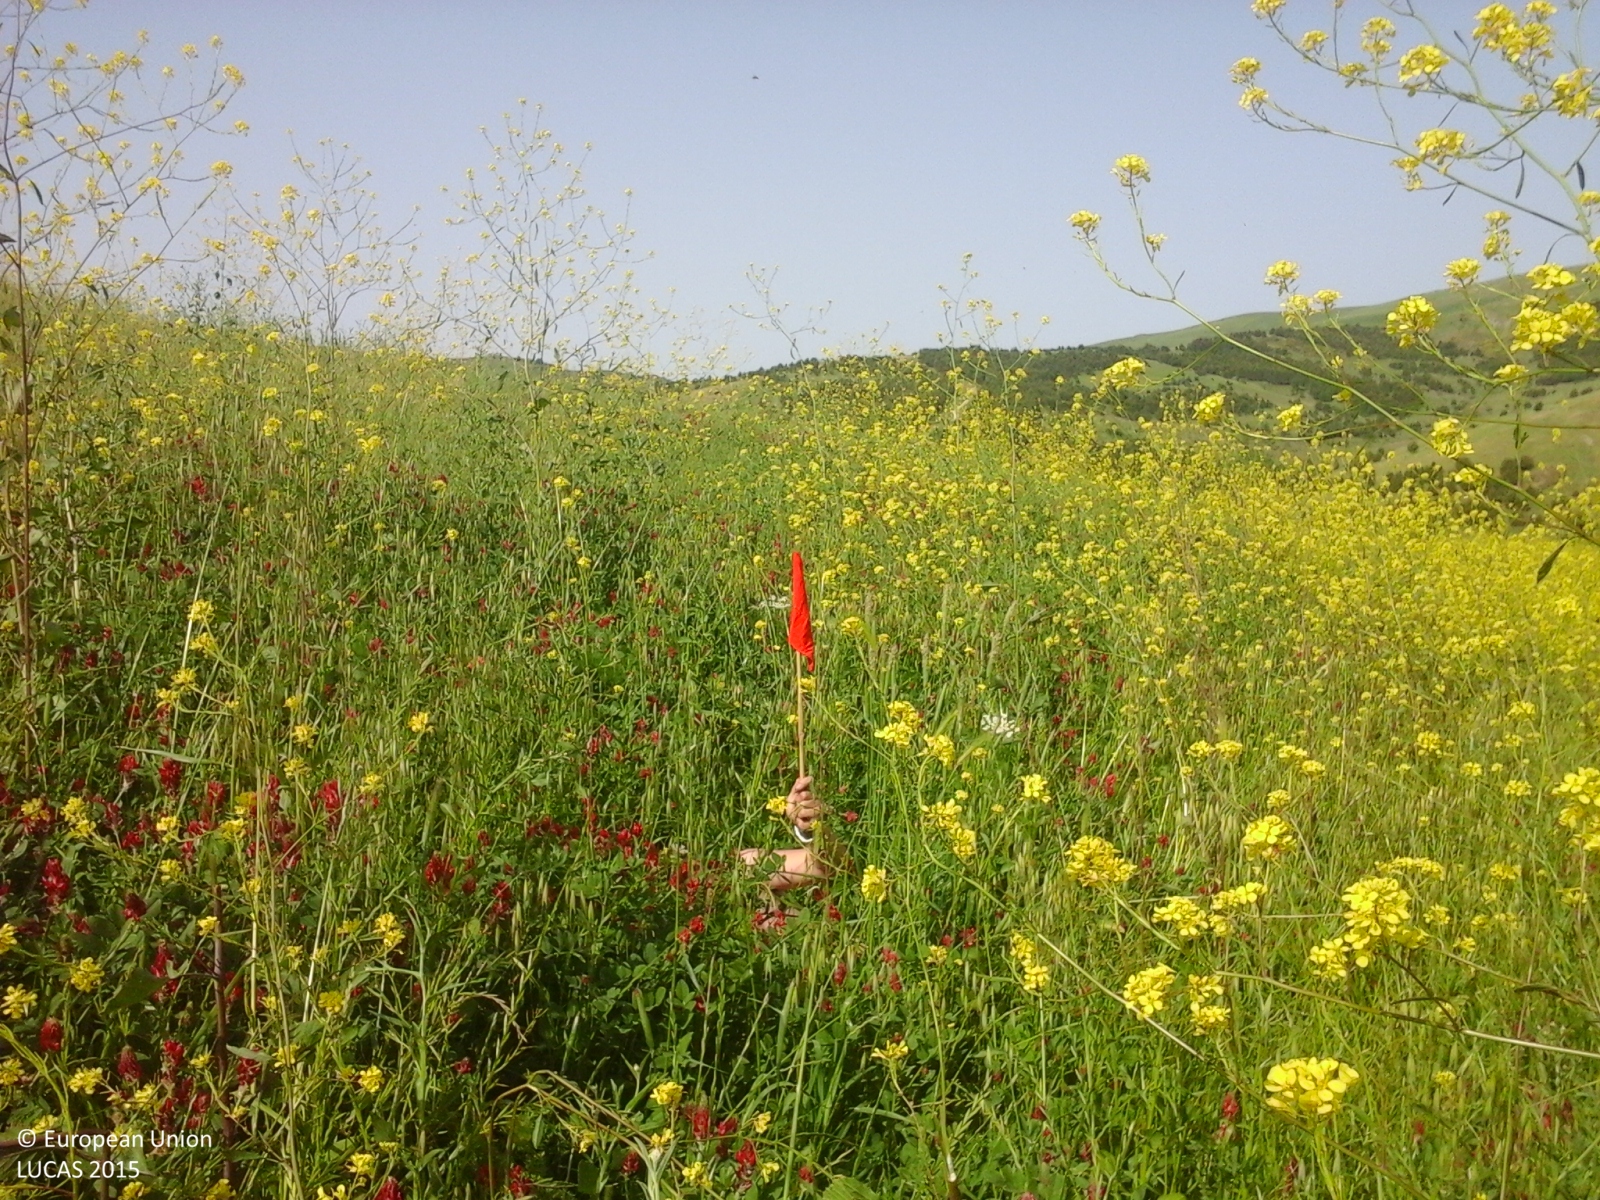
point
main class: Cropland
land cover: Temporary grasslands
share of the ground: > 75 %
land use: Agriculture (excluding fallow land and kitchen gardens)
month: May
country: IT
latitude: 37.7303
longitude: 14.1344
